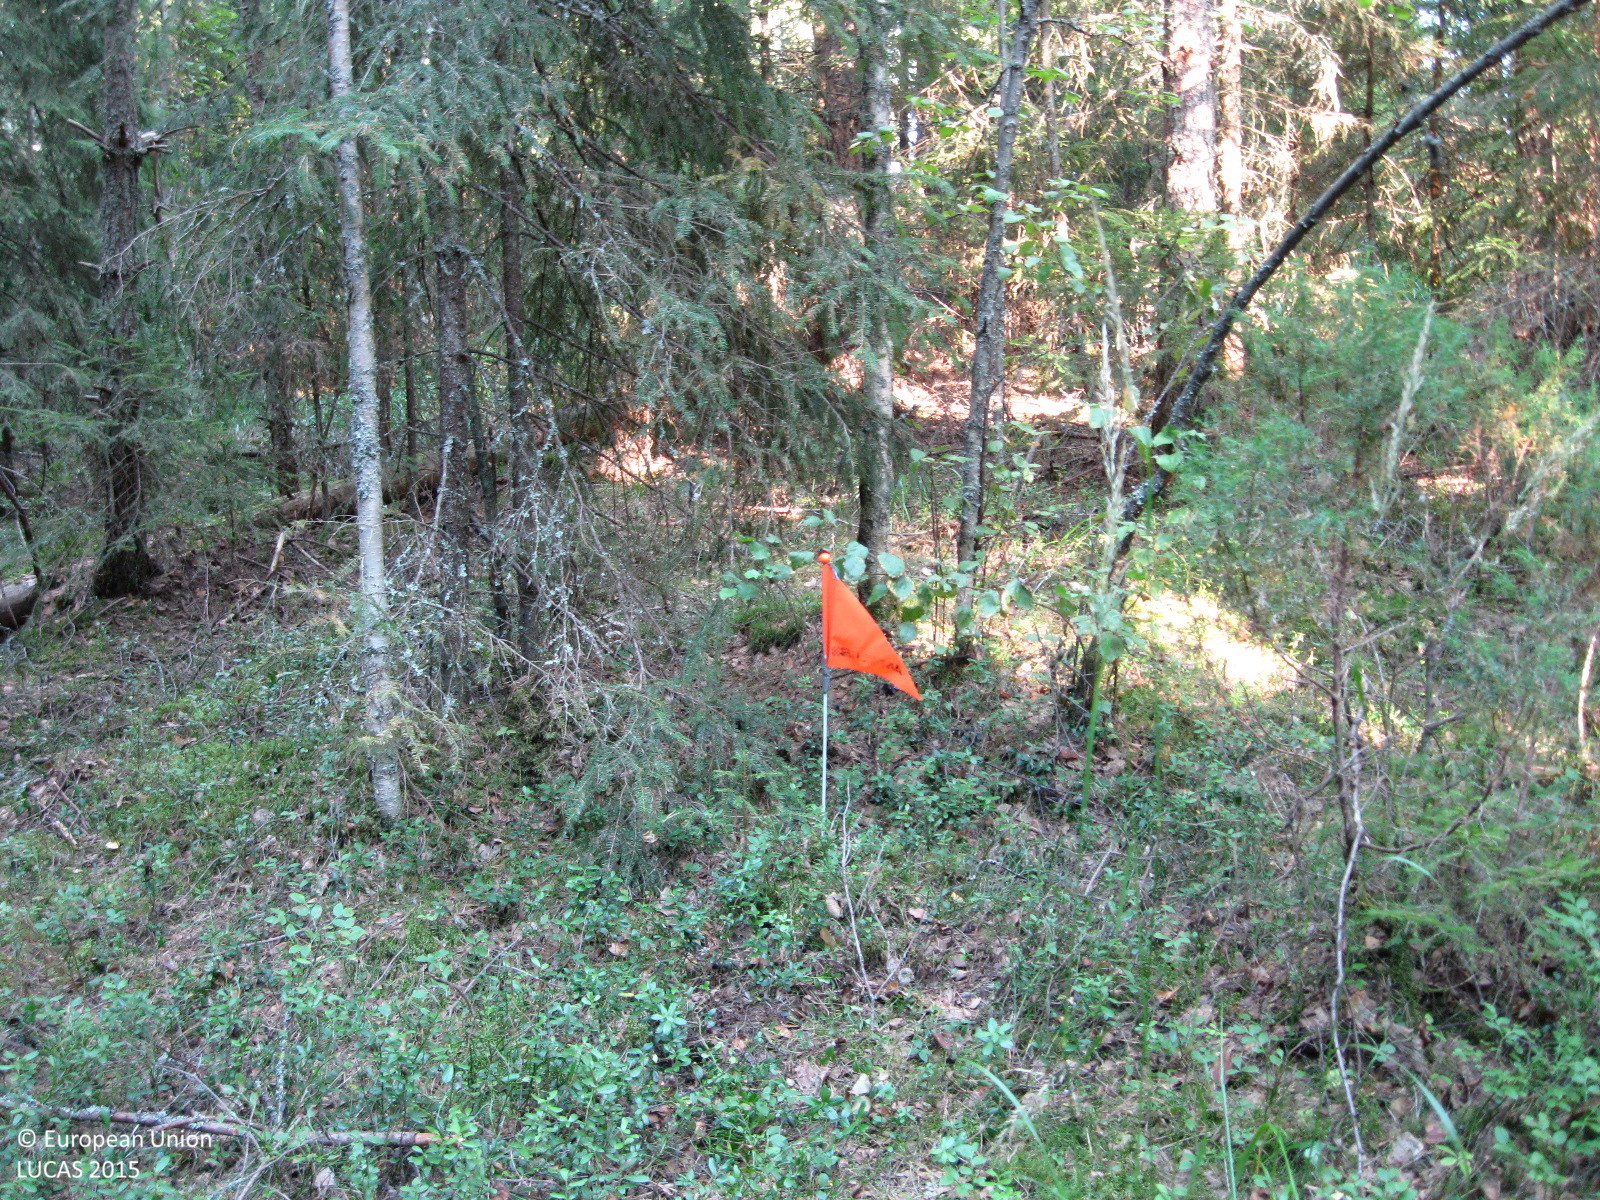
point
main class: Woodland
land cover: Pine dominated mixed woodland
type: boreal forest
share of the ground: > 75 %
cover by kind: coniferous forest trees 65 %, broadleaved forest trees 25 %, shrubs 5 %, herbaceous plants 5 %
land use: Forestry
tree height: > 5 m
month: August
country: FI
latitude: 61.2903
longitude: 25.2895
